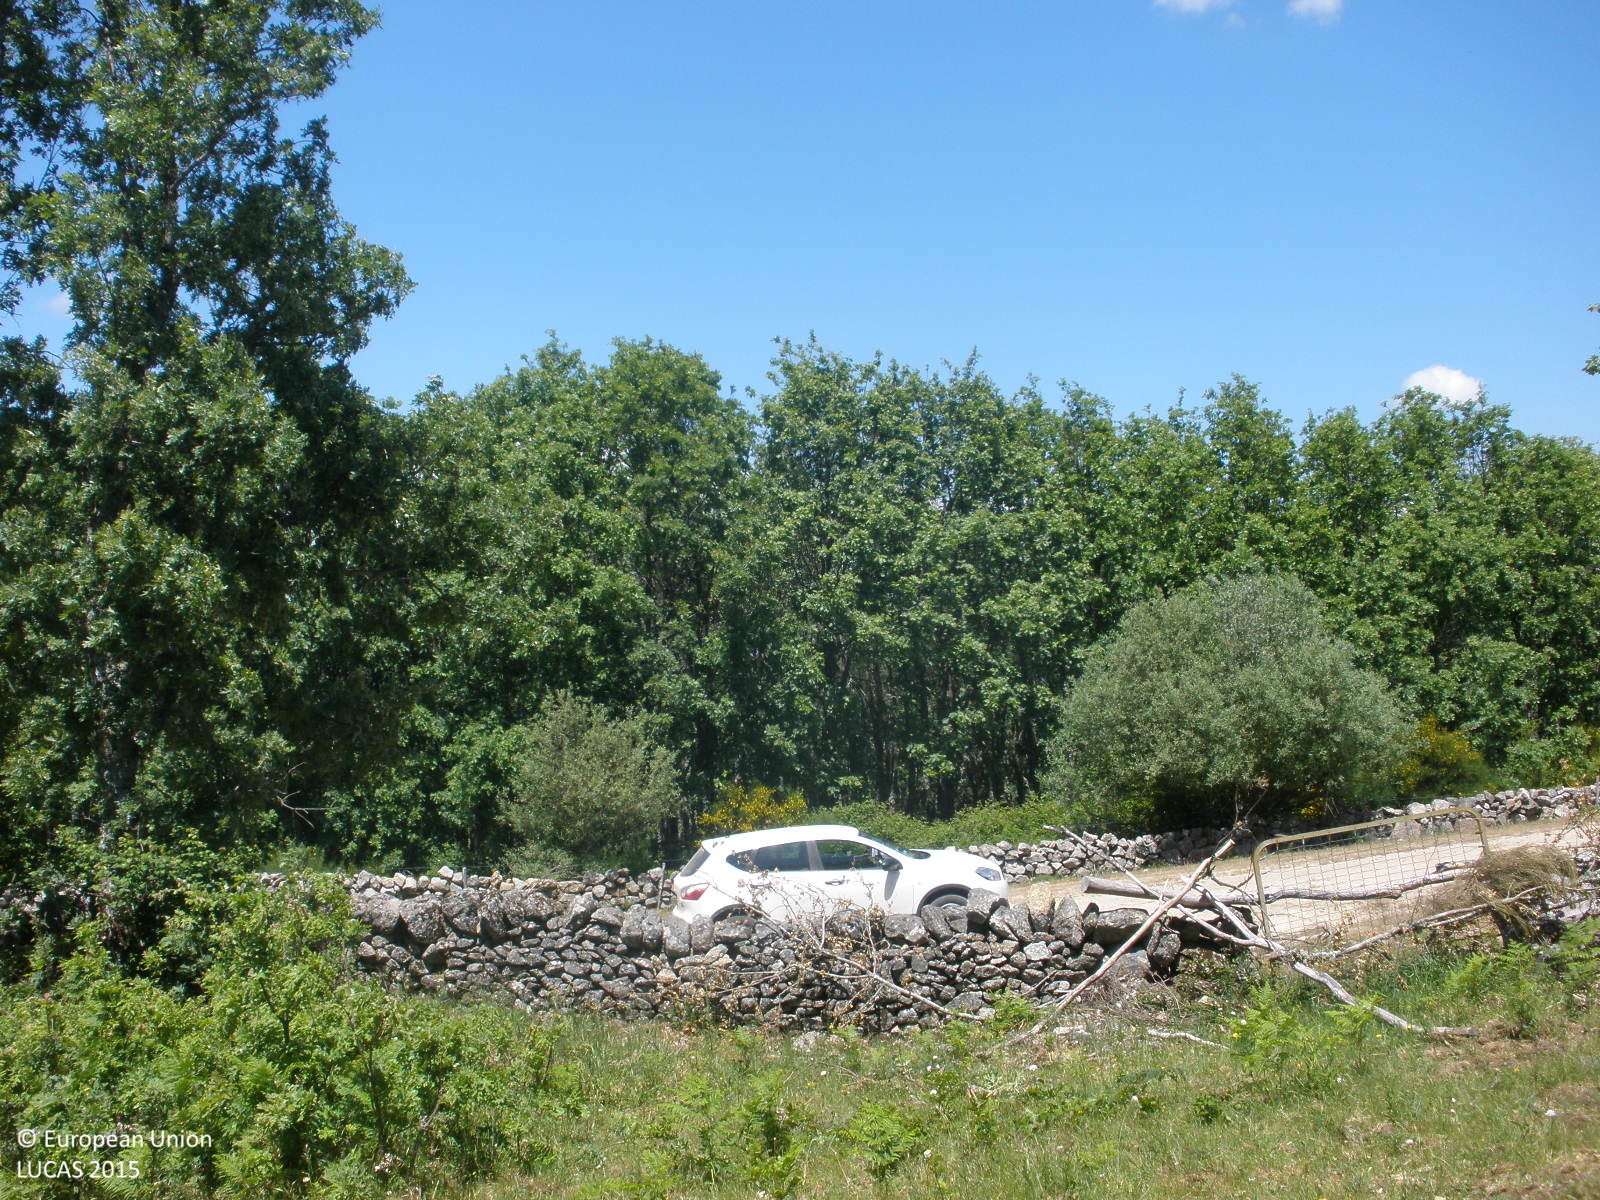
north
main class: Woodland
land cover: Broadleaved woodland
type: broadleaved evergreen forest
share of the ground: > 75 %
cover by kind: broadleaved forest trees 80 %, herbaceous plants 20 %
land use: Agriculture (excluding fallow land and kitchen gardens)
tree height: > 5 m
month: May
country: ES
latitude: 40.3224
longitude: -5.9014
